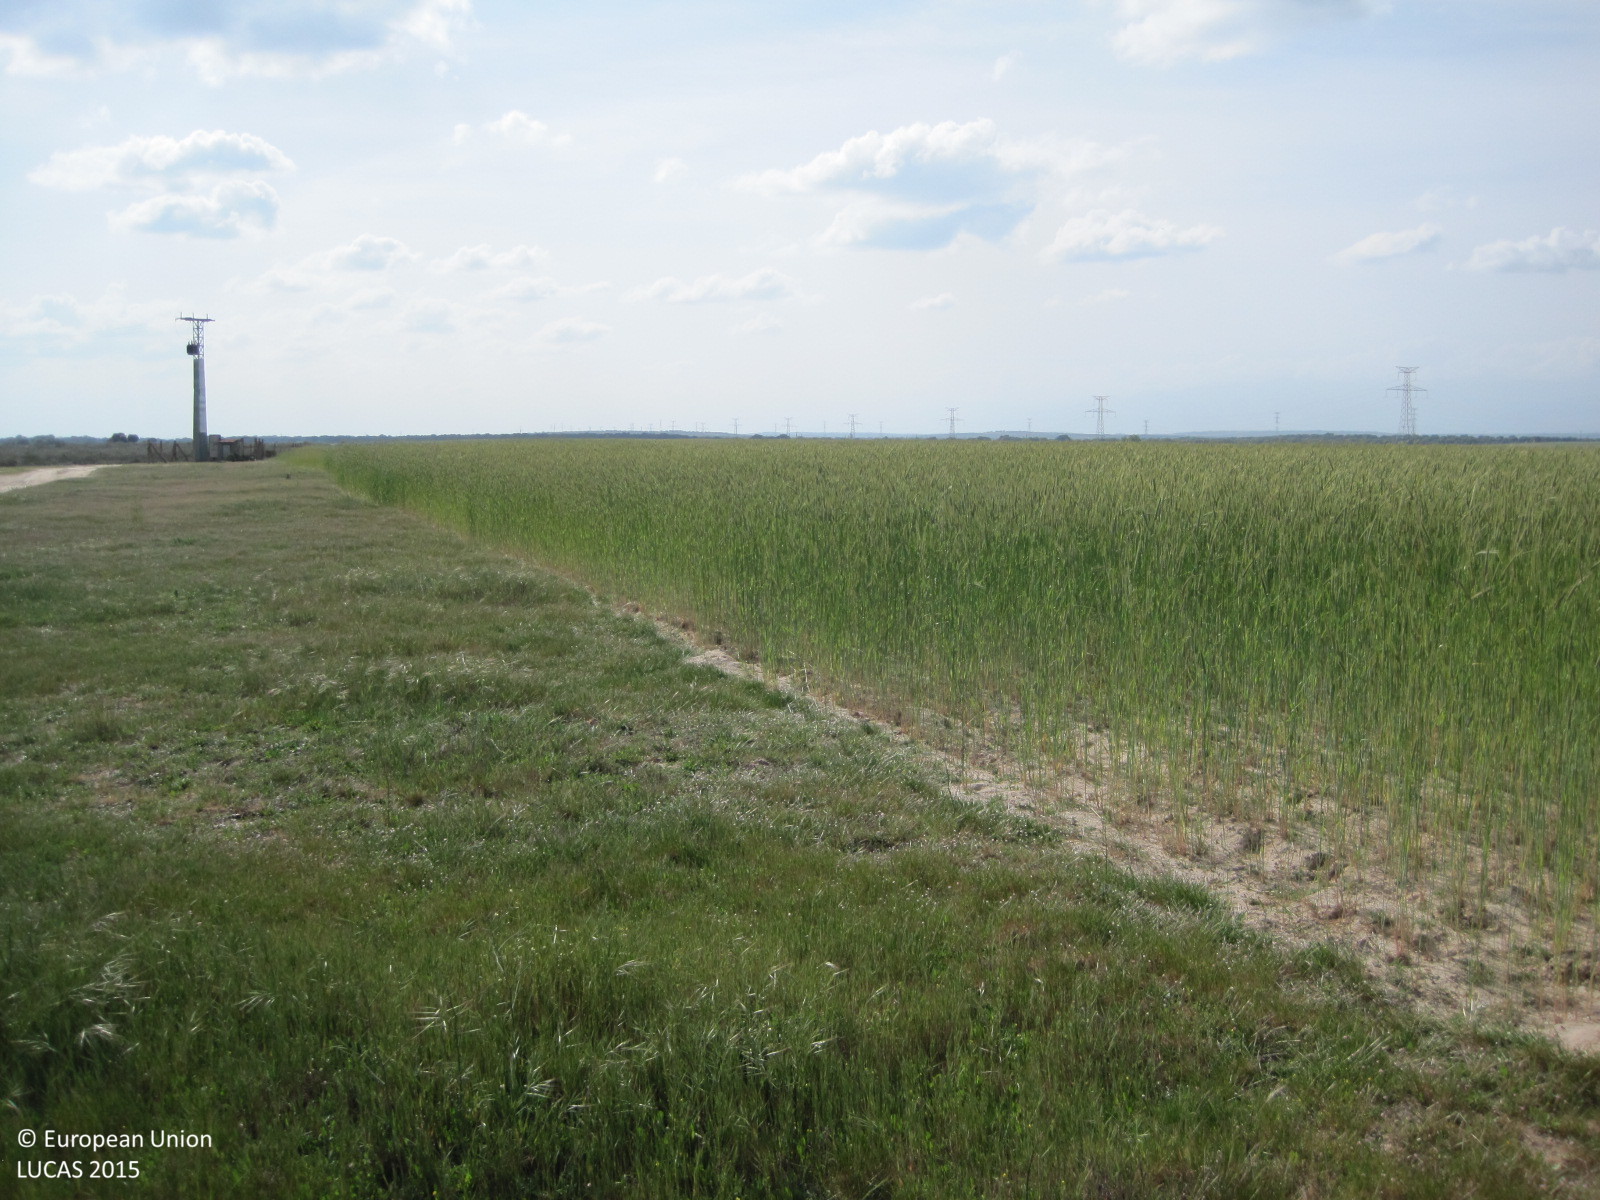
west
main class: Grassland
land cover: Grassland without tree/shrub cover
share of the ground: > 75 %
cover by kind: herbaceous plants 100 %
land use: Agriculture (excluding fallow land and kitchen gardens)
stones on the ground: 10 - 25 %
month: April
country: ES
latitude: 40.0087
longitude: -4.9873
